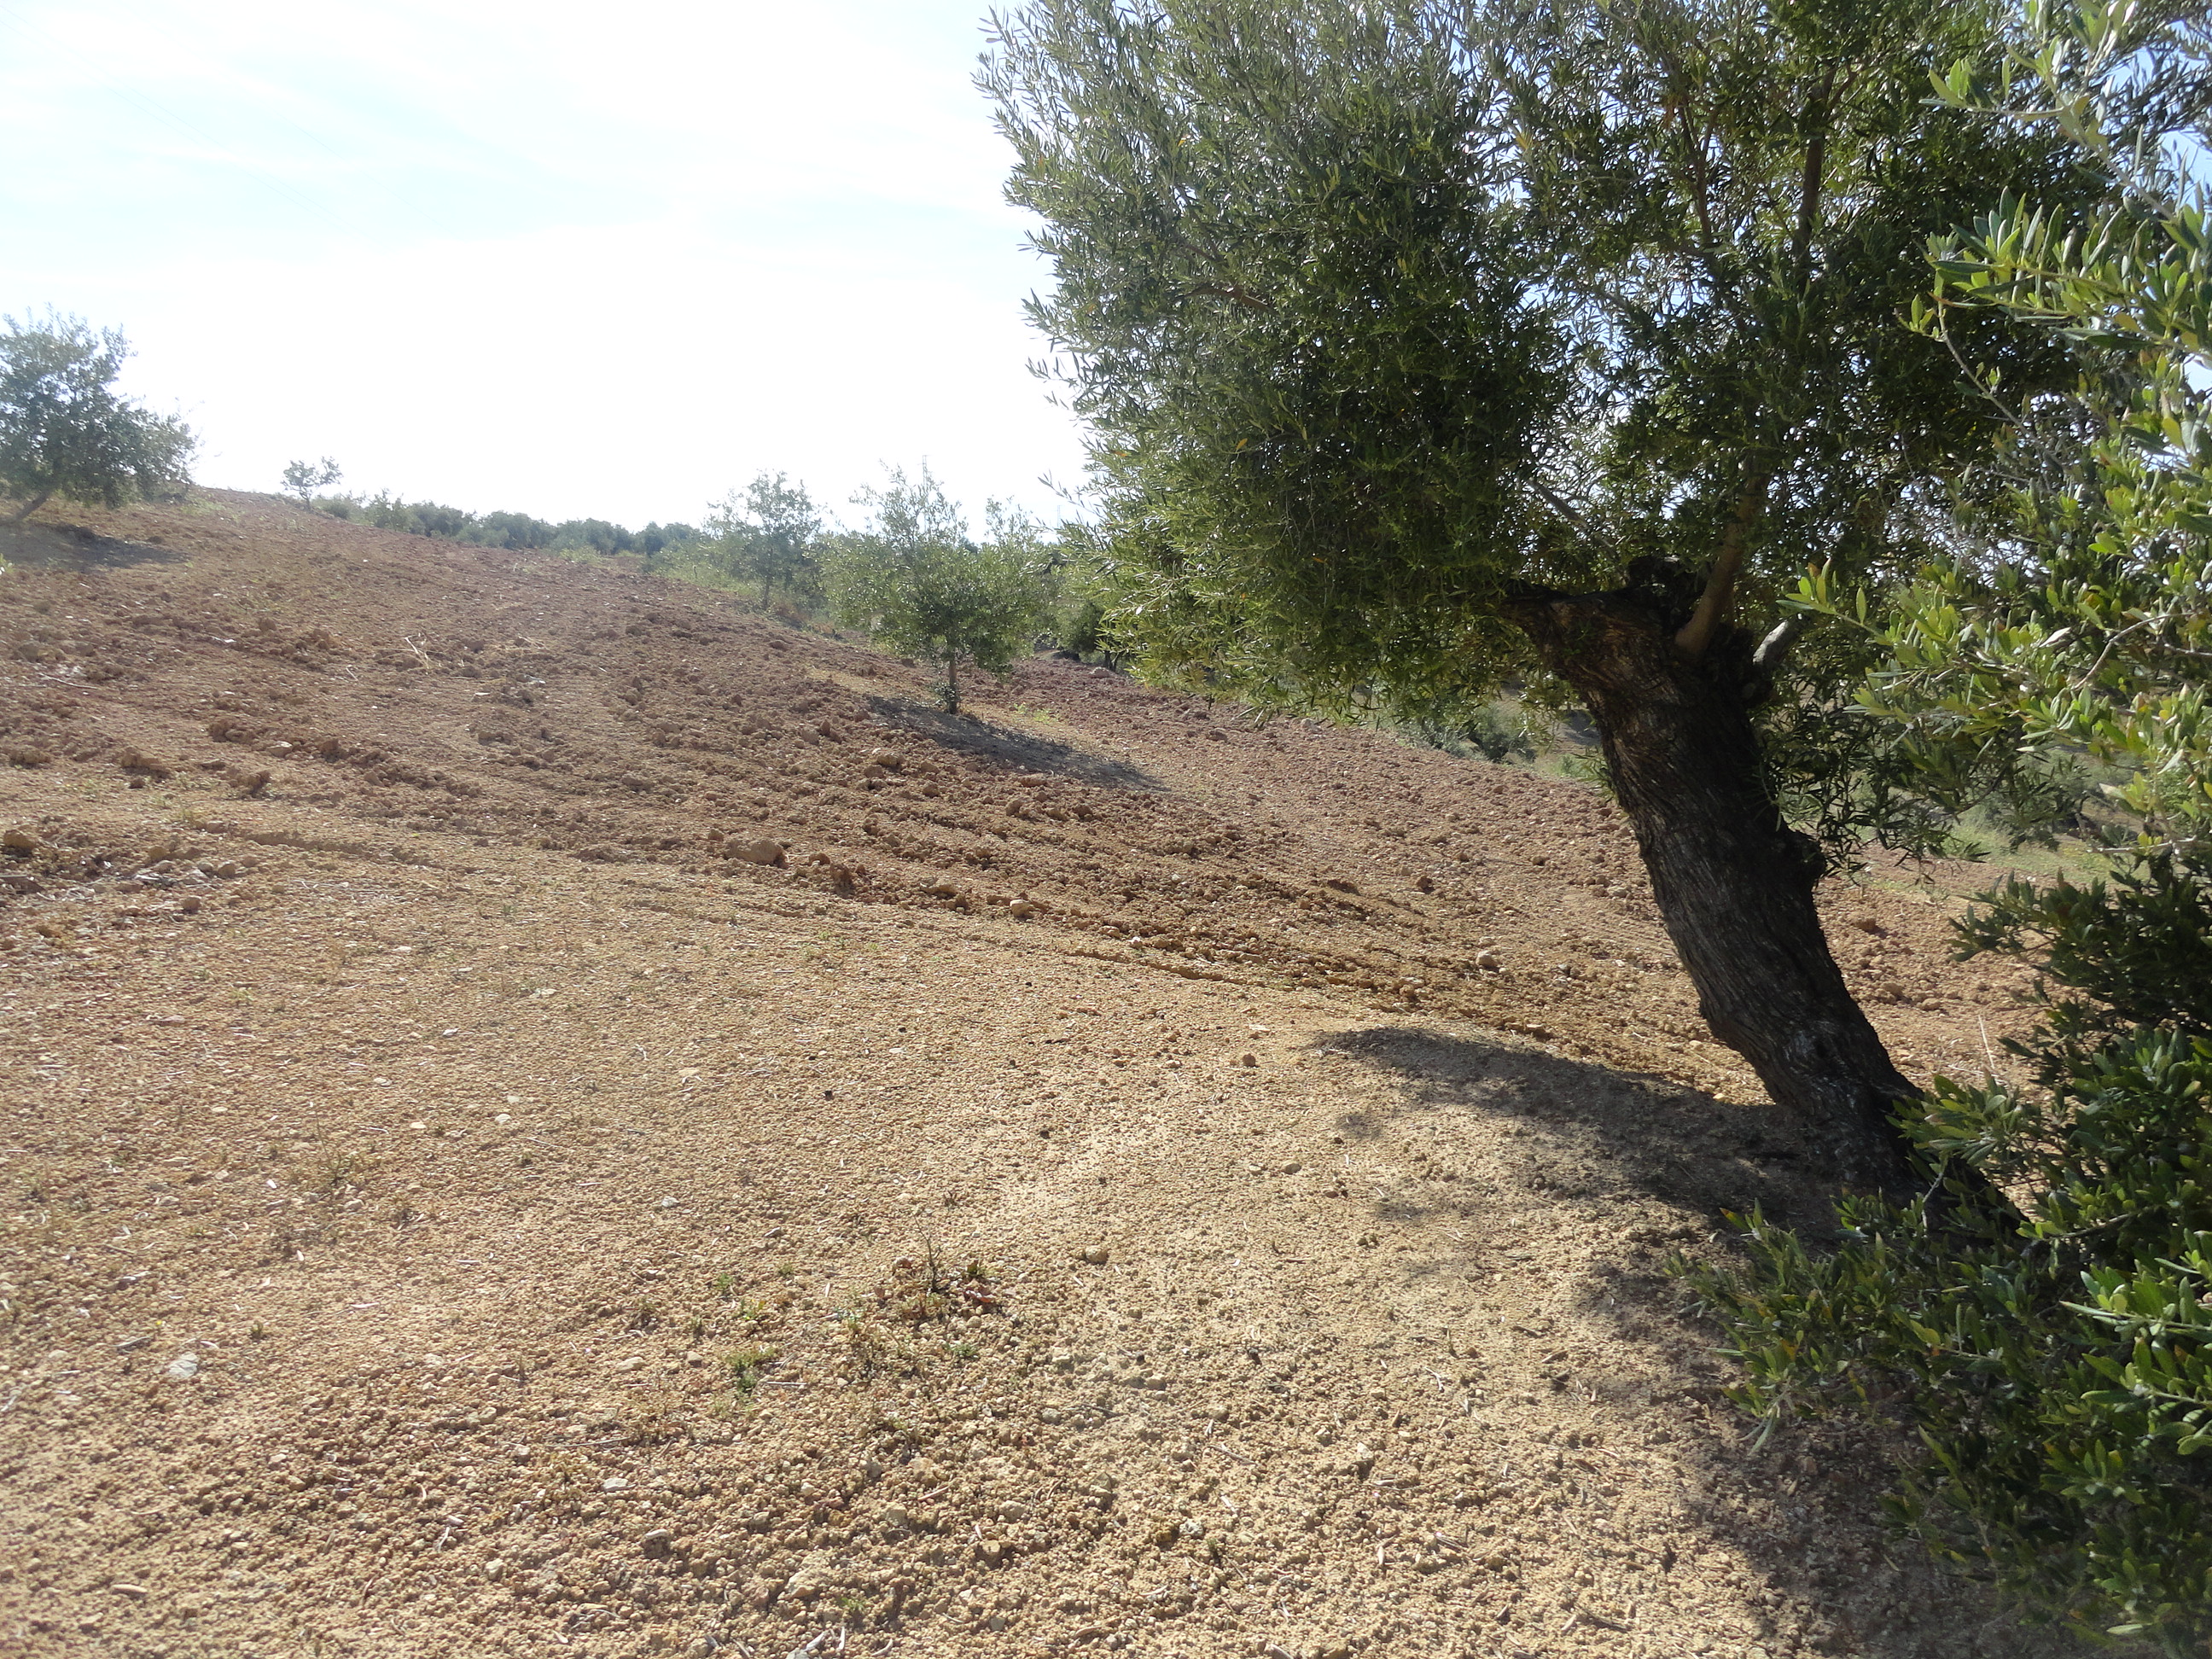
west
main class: Cropland
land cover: Olive groves
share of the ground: 25 - 50 %
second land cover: Other bare soil
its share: > 75 %
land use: Agriculture (excluding fallow land and kitchen gardens)
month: April
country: ES
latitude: 37.6545
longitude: -4.4125
